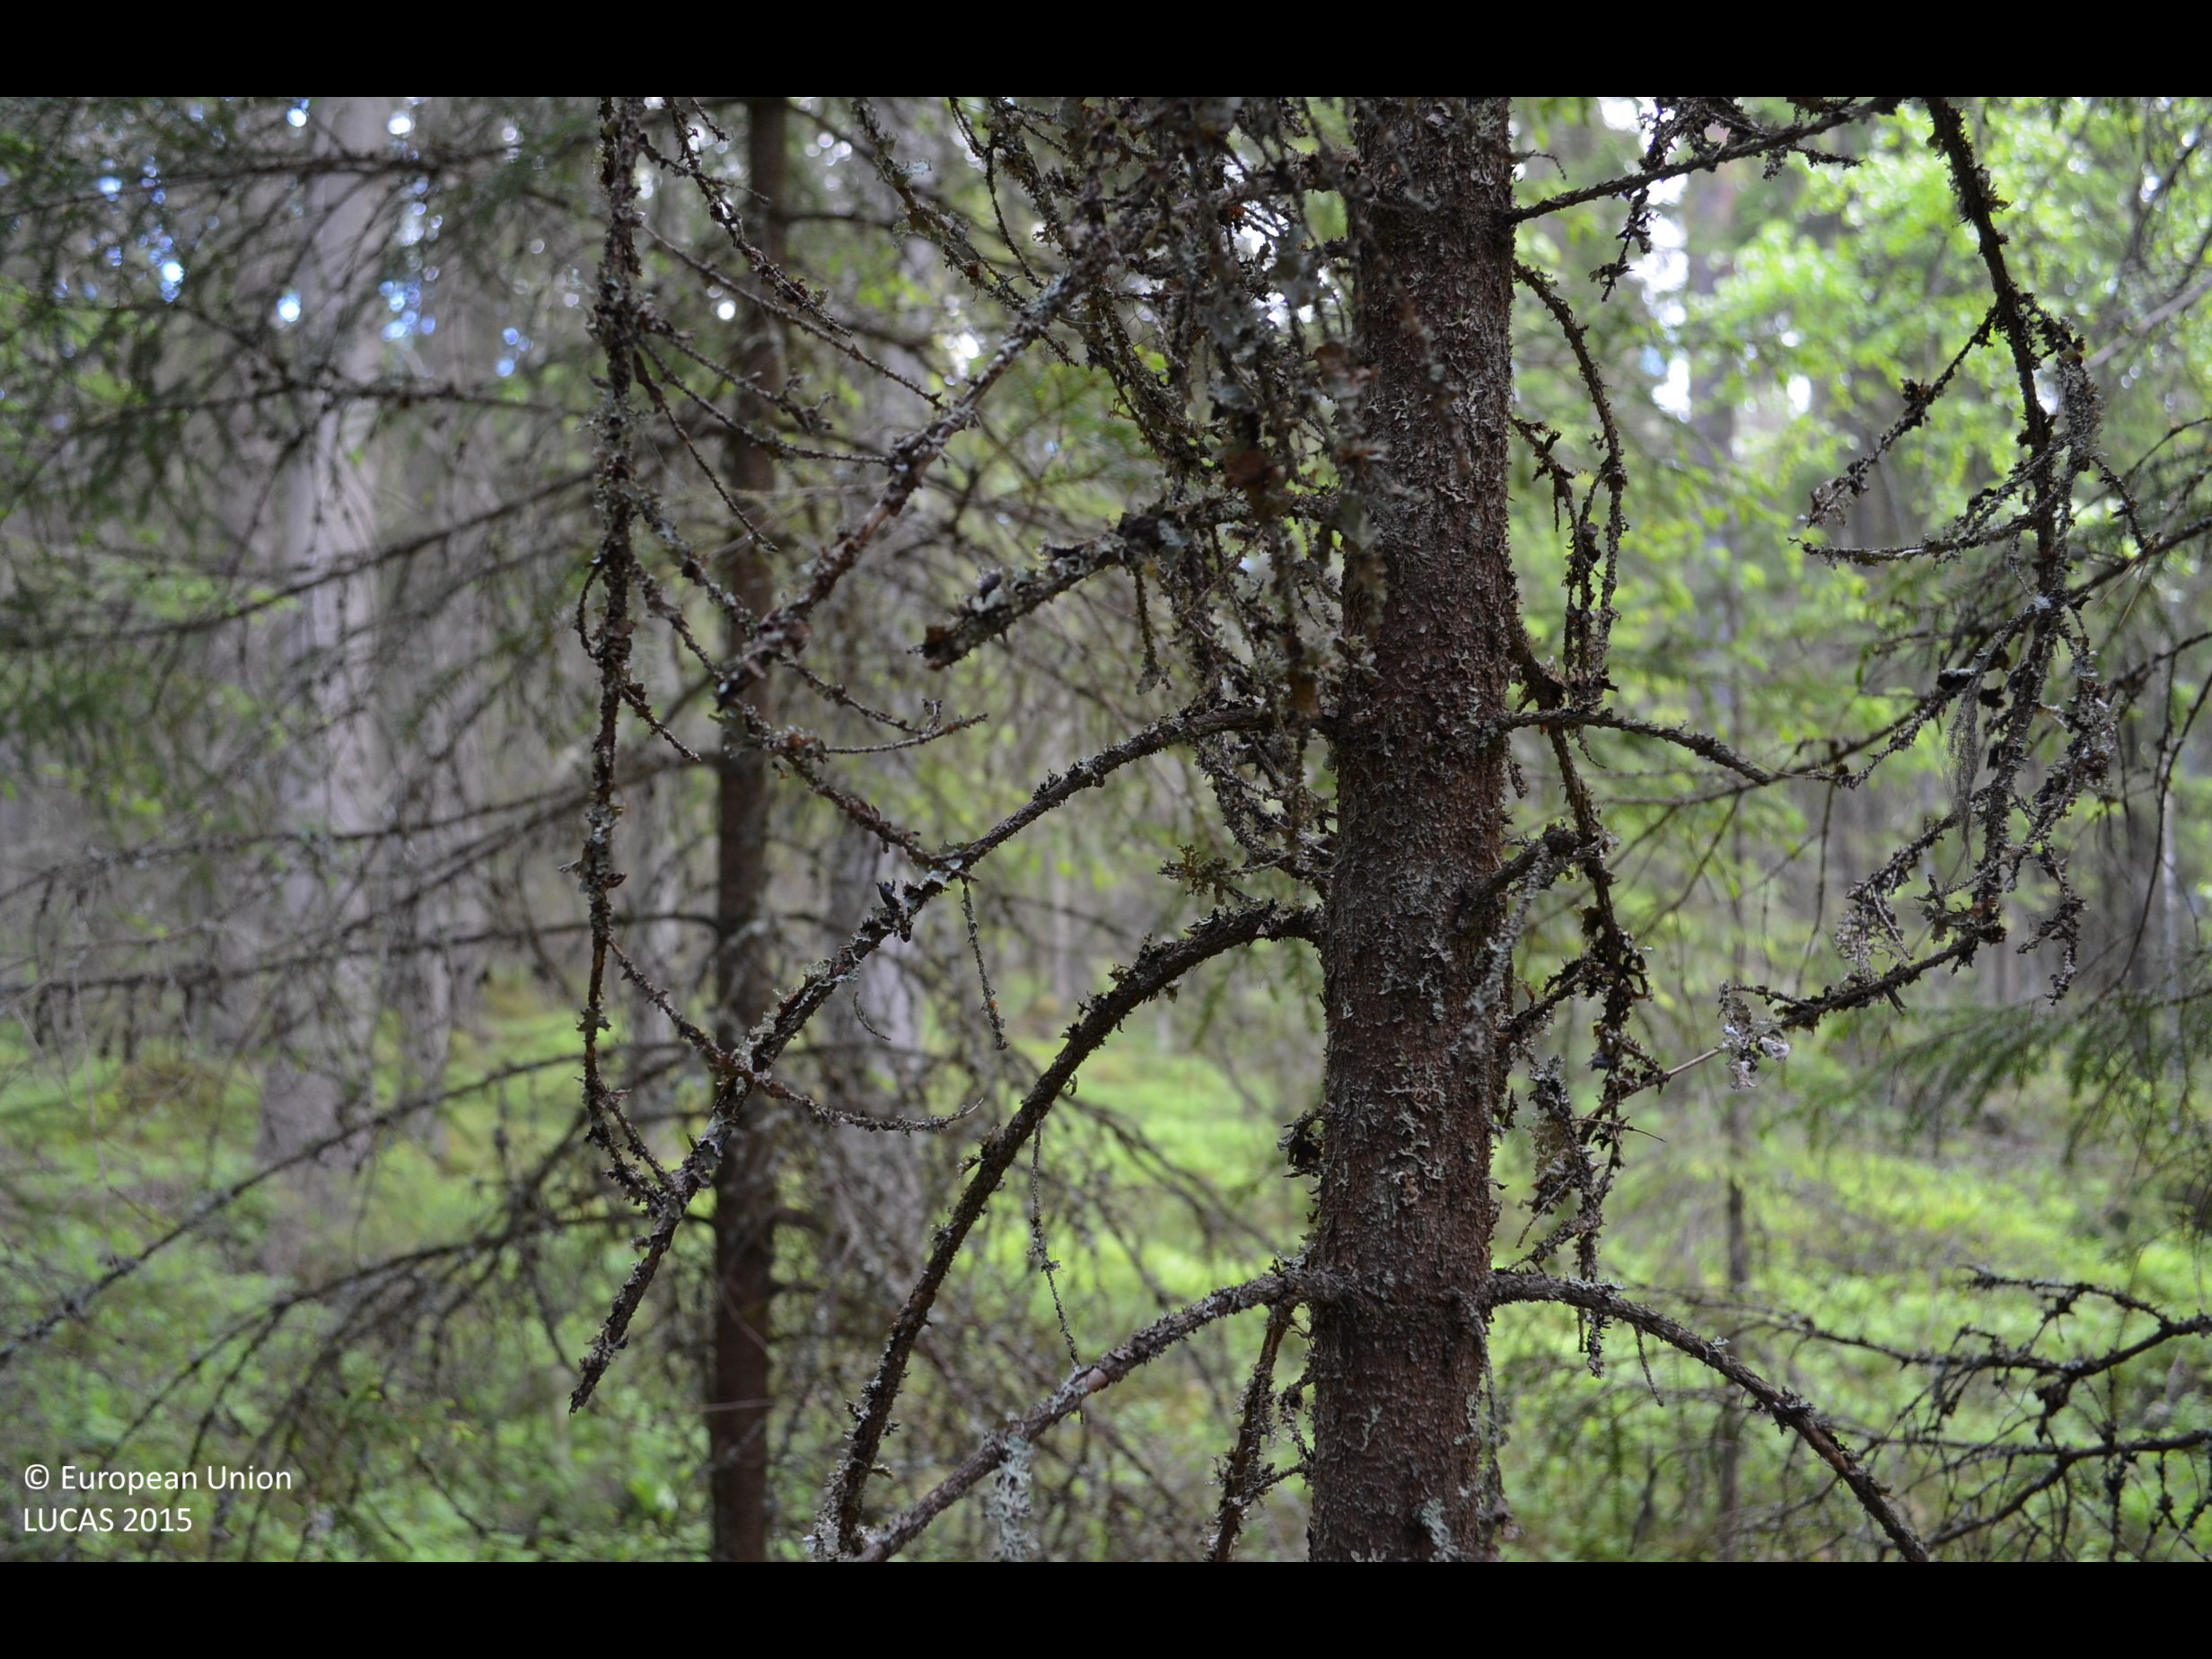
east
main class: Woodland
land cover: Spruce dominated coniferous woodland
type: boreal forest
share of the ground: > 75 %
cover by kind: coniferous forest trees 75 %, shrubs 20 %, broadleaved forest trees 5 %
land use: Semi-natural and natural areas not in use
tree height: > 5 m
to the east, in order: Spruce dominated coniferous woodland; Other coniferous woodland
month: June
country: FI
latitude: 61.9338
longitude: 23.4305
